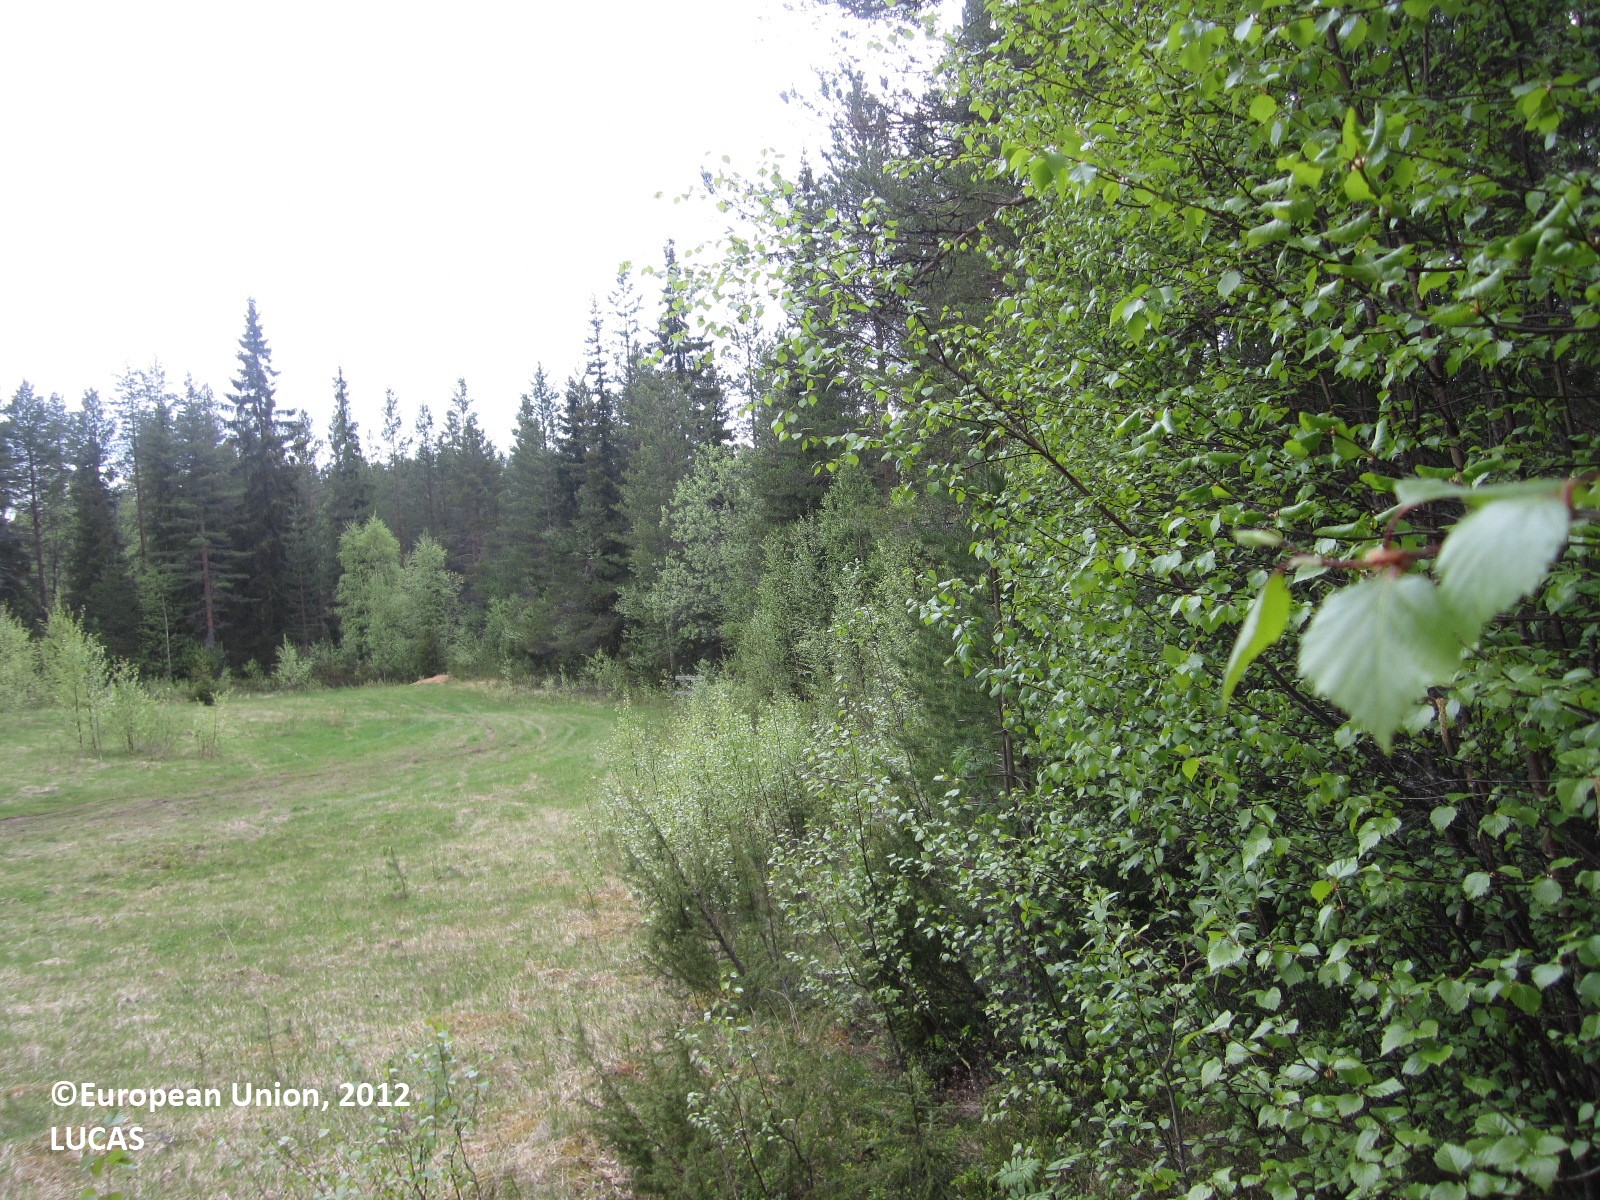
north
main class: Woodland
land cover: Pine dominated mixed woodland
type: boreal forest
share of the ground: > 75 %
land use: Forestry
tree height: > 5 m
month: June
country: FI
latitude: 64.7728
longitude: 28.7926
